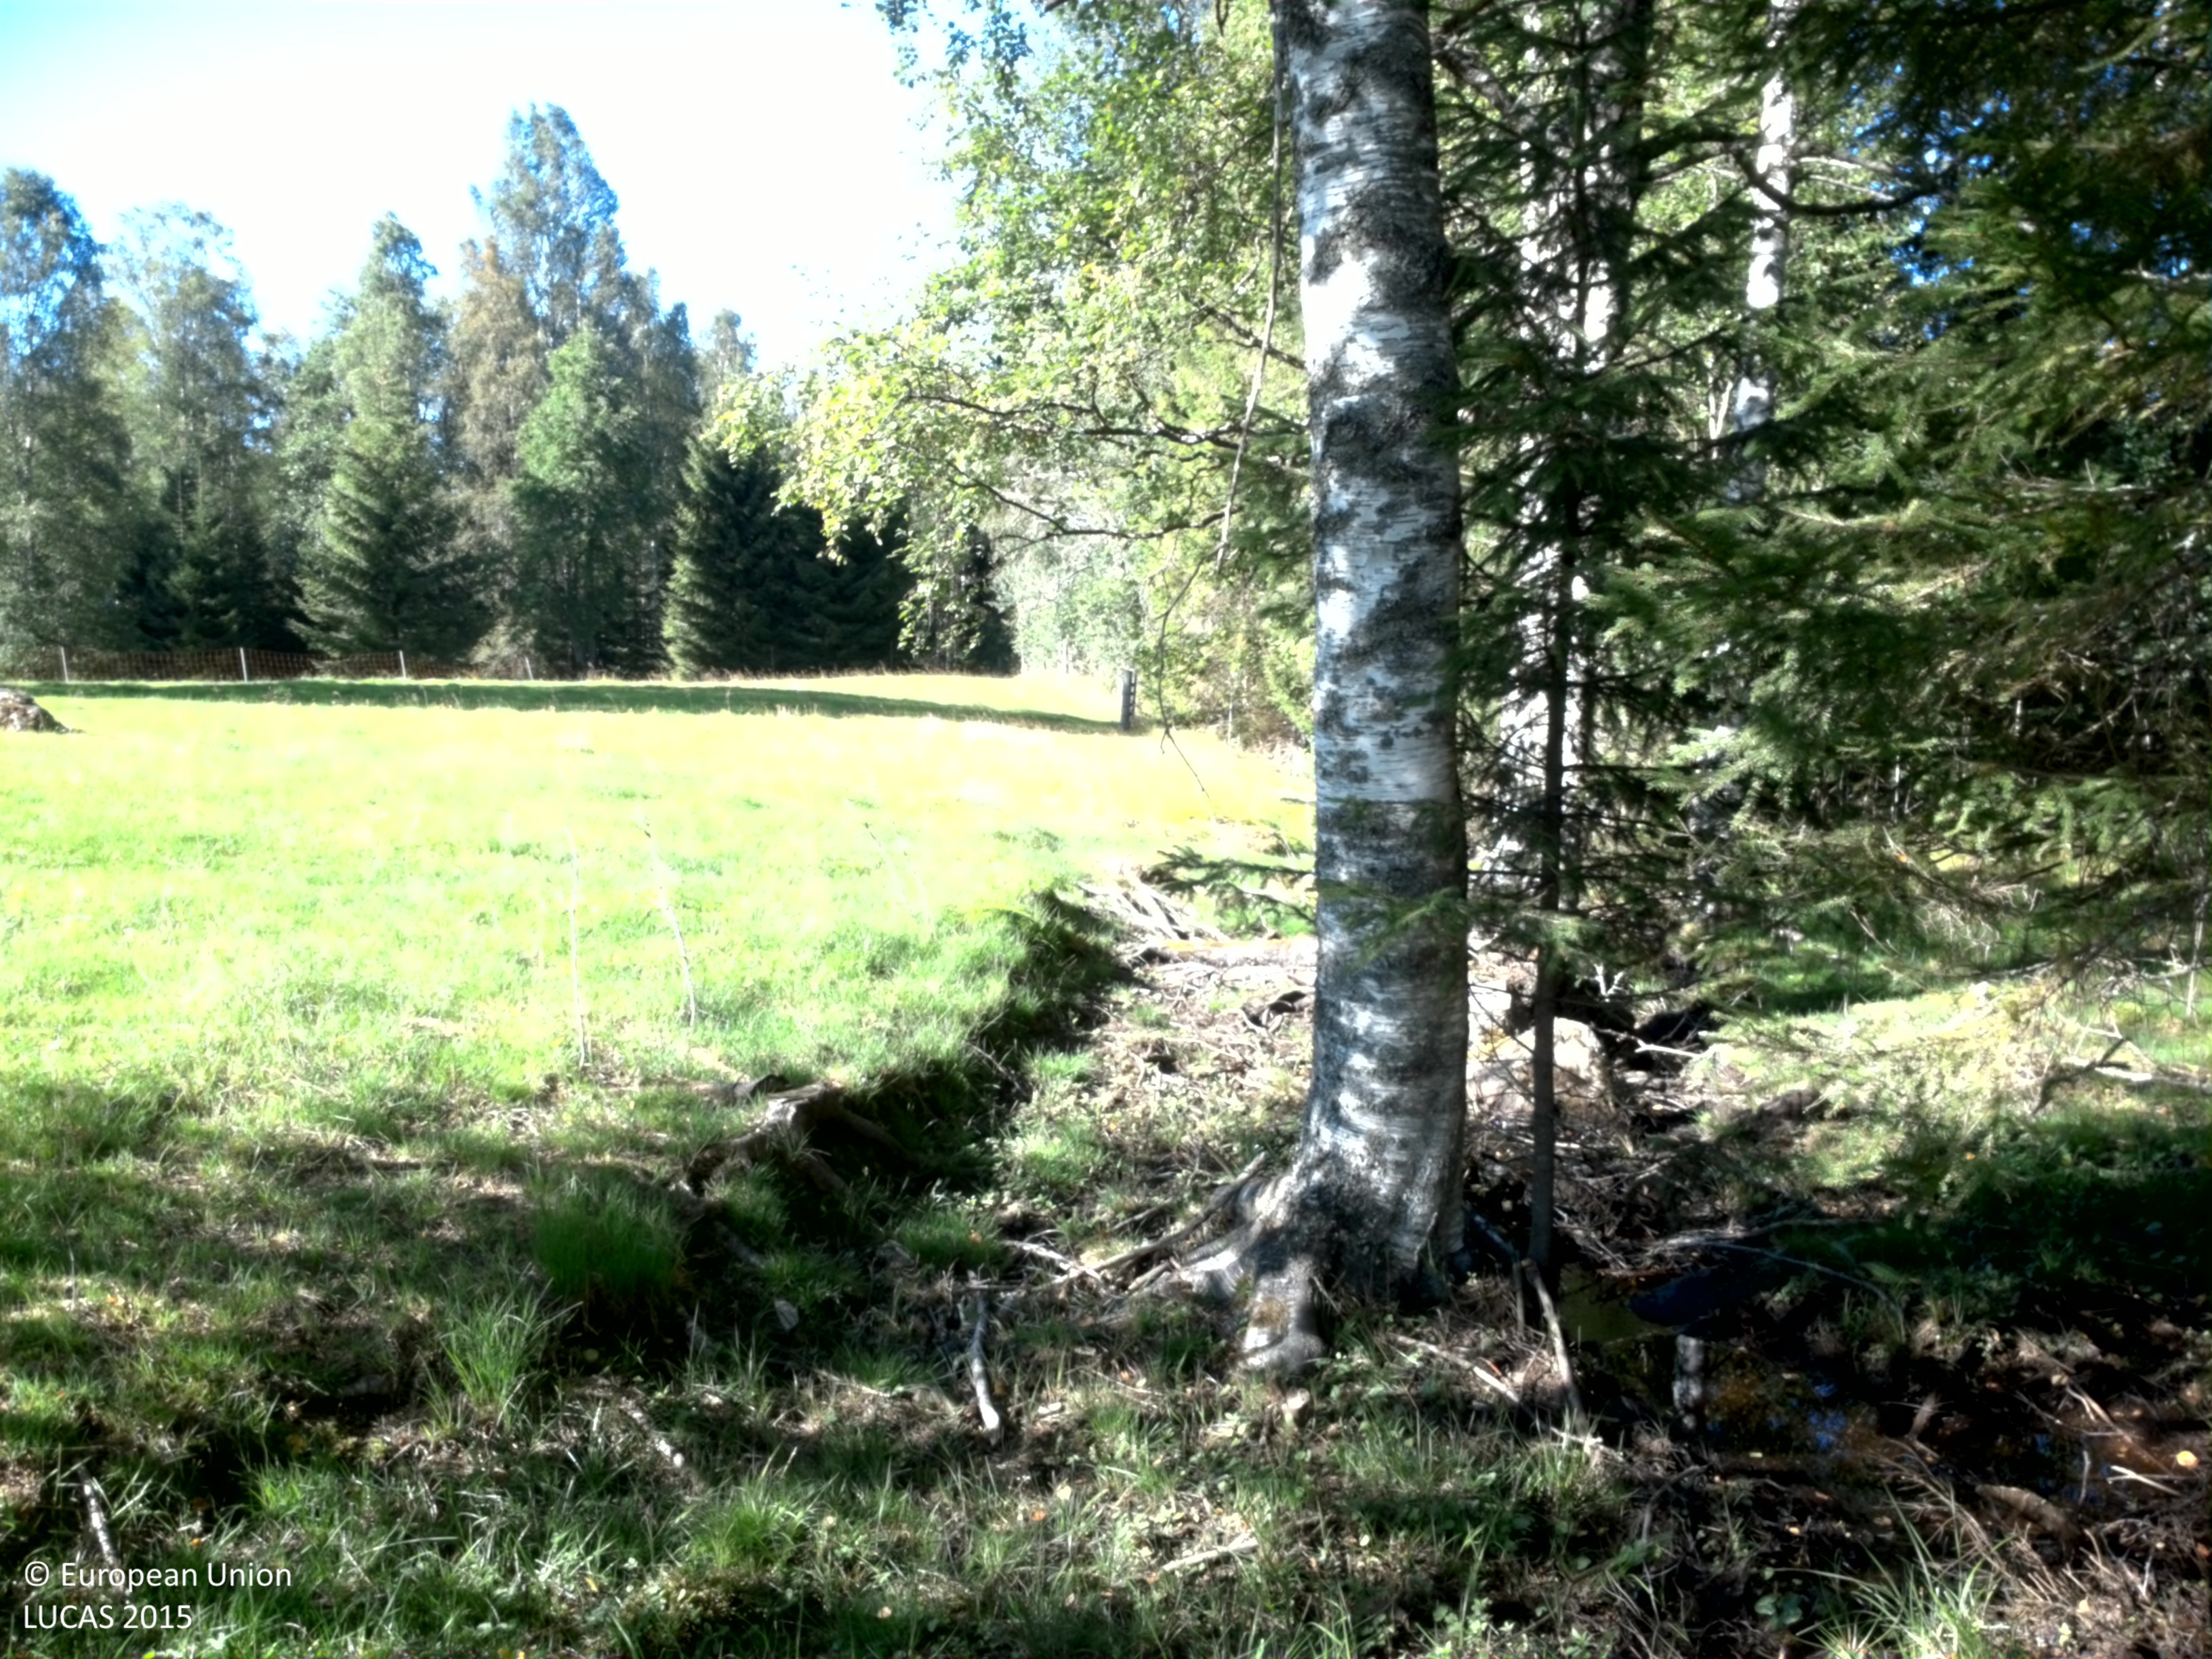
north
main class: Woodland
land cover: Broadleaved woodland
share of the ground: 50 - 75 %
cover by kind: broadleaved forest trees 50 %, herbaceous plants 40 %, coniferous forest trees 10 %
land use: Agriculture (excluding fallow land and kitchen gardens)
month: August
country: SE
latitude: 59.9369
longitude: 14.2314
